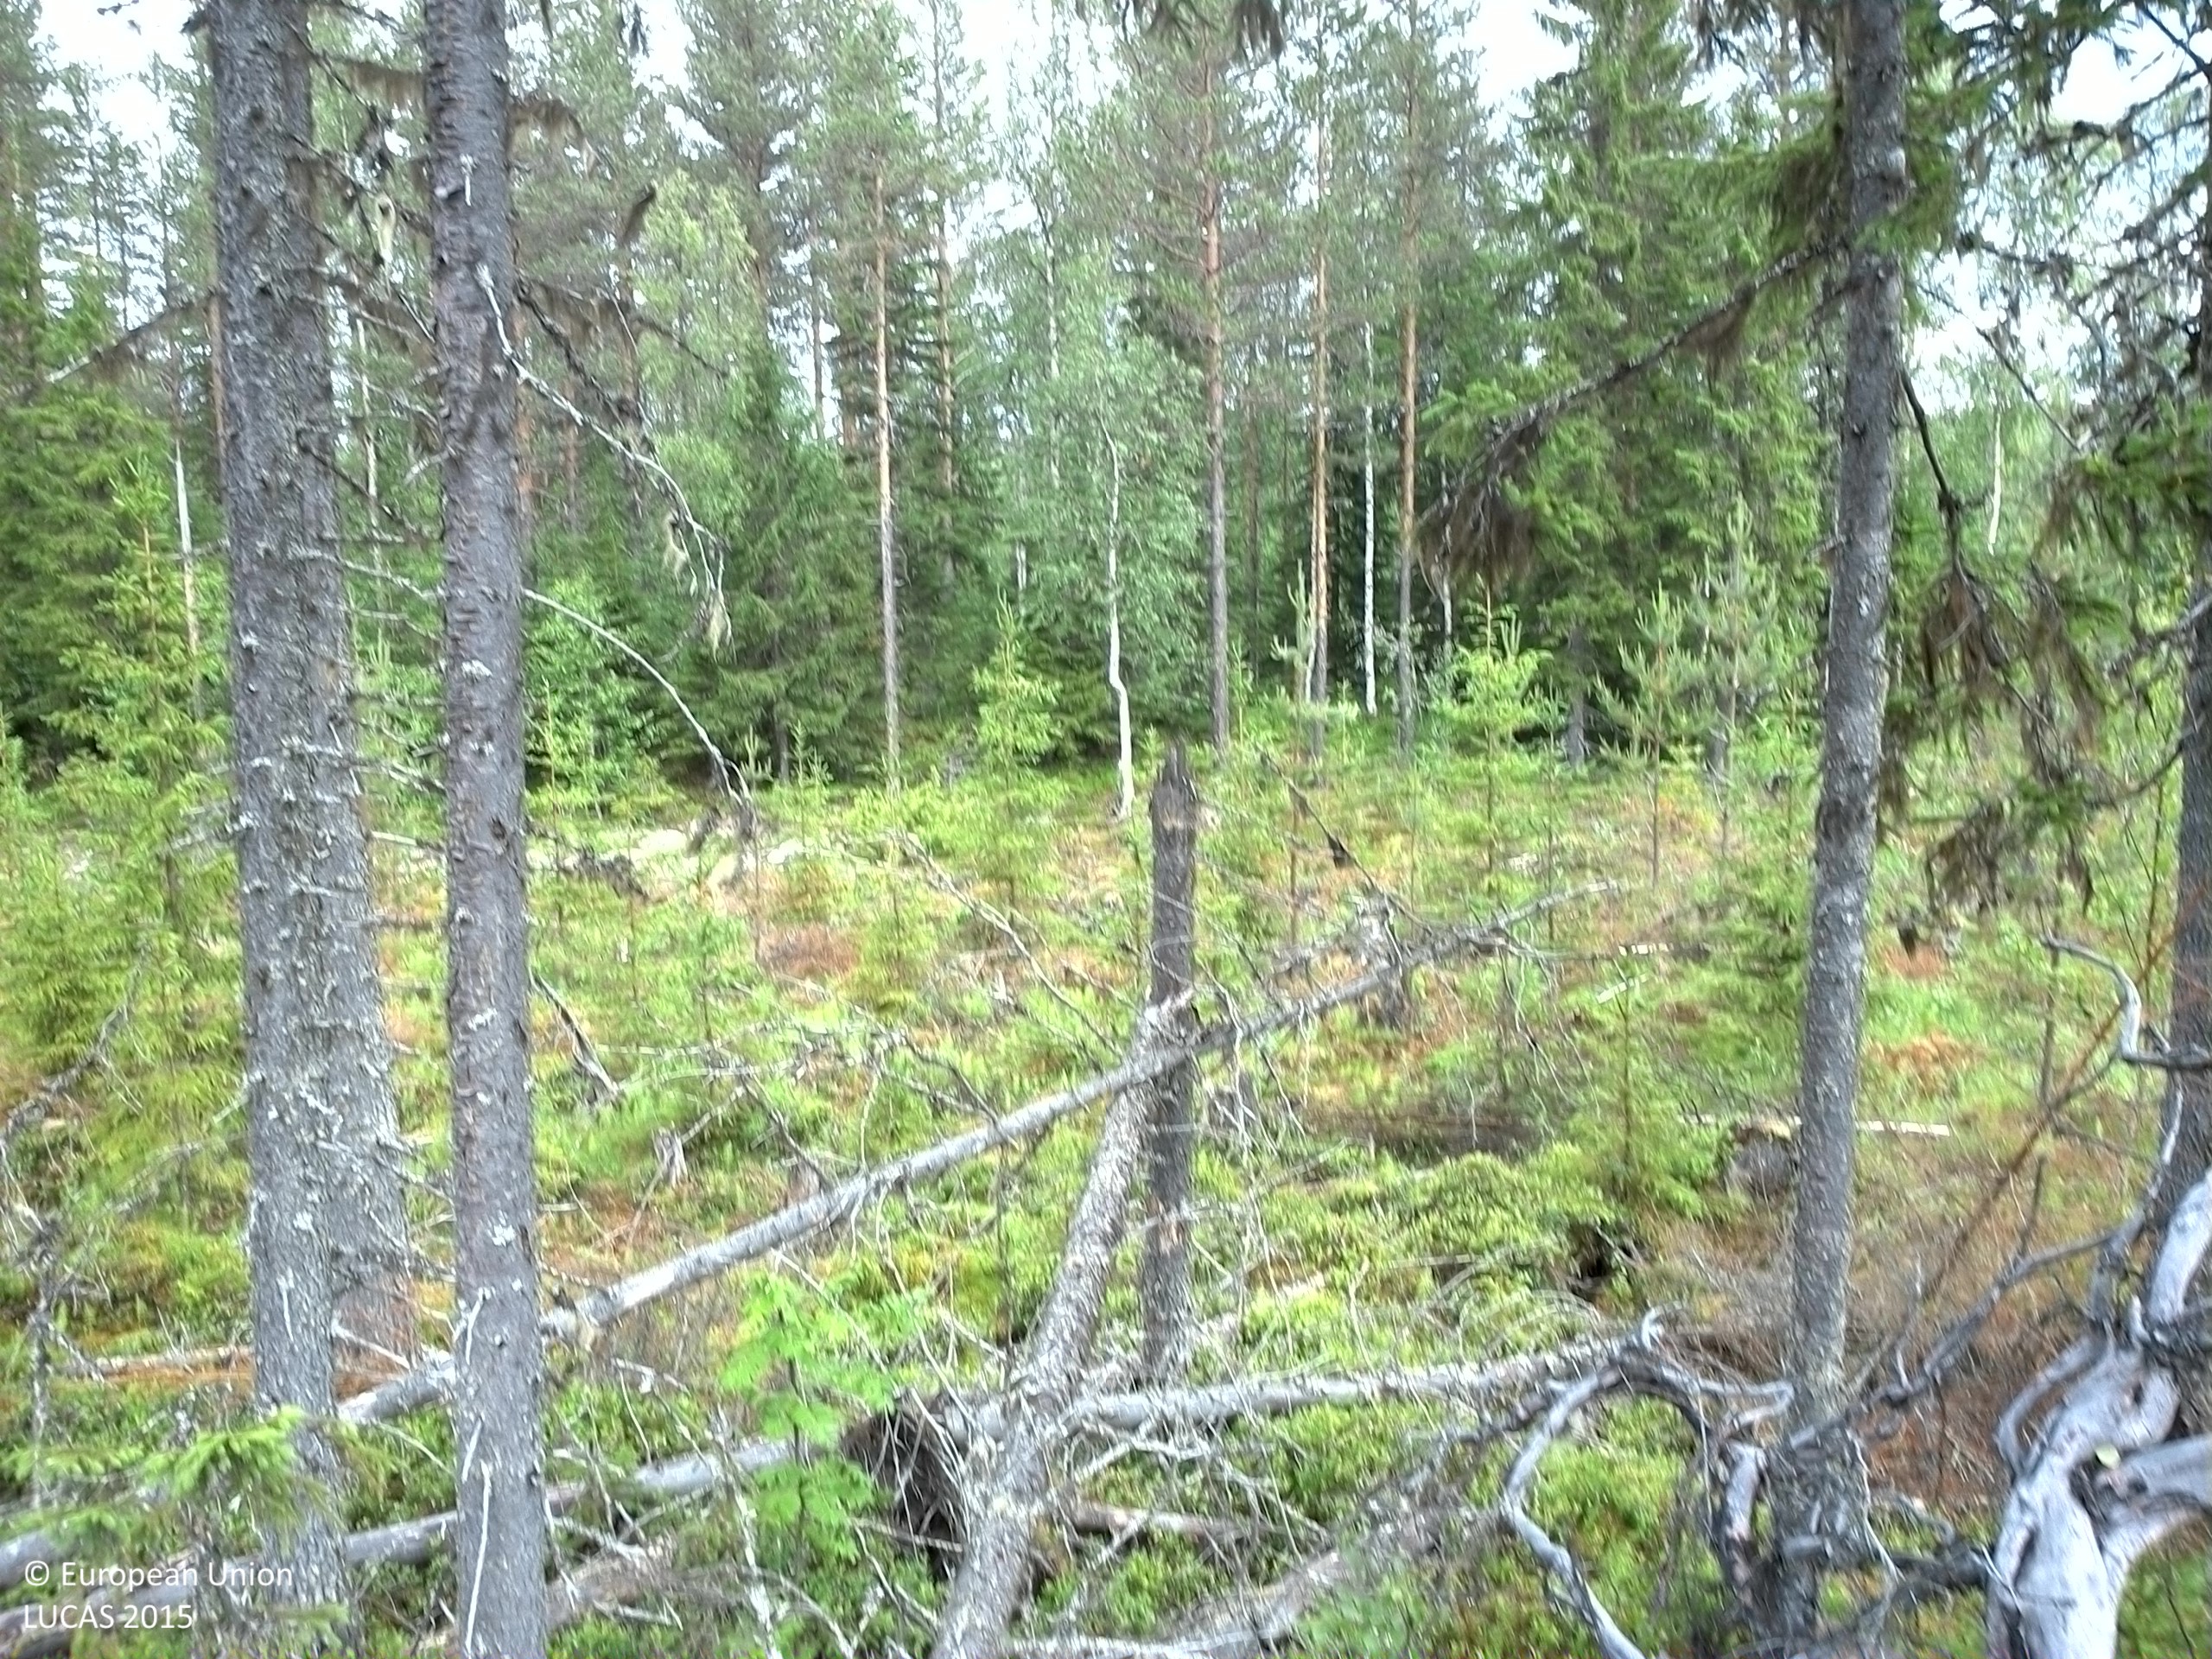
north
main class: Woodland
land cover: Spruce dominated coniferous woodland
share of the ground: 25 - 50 %
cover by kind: coniferous forest trees 30 %, shrubs 30 %, lichens and mosses 20 %, herbaceous plants 15 %, broadleaved forest trees 5 %
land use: Forestry
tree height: > 5 m
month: July
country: SE
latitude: 63.5214
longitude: 18.3986
